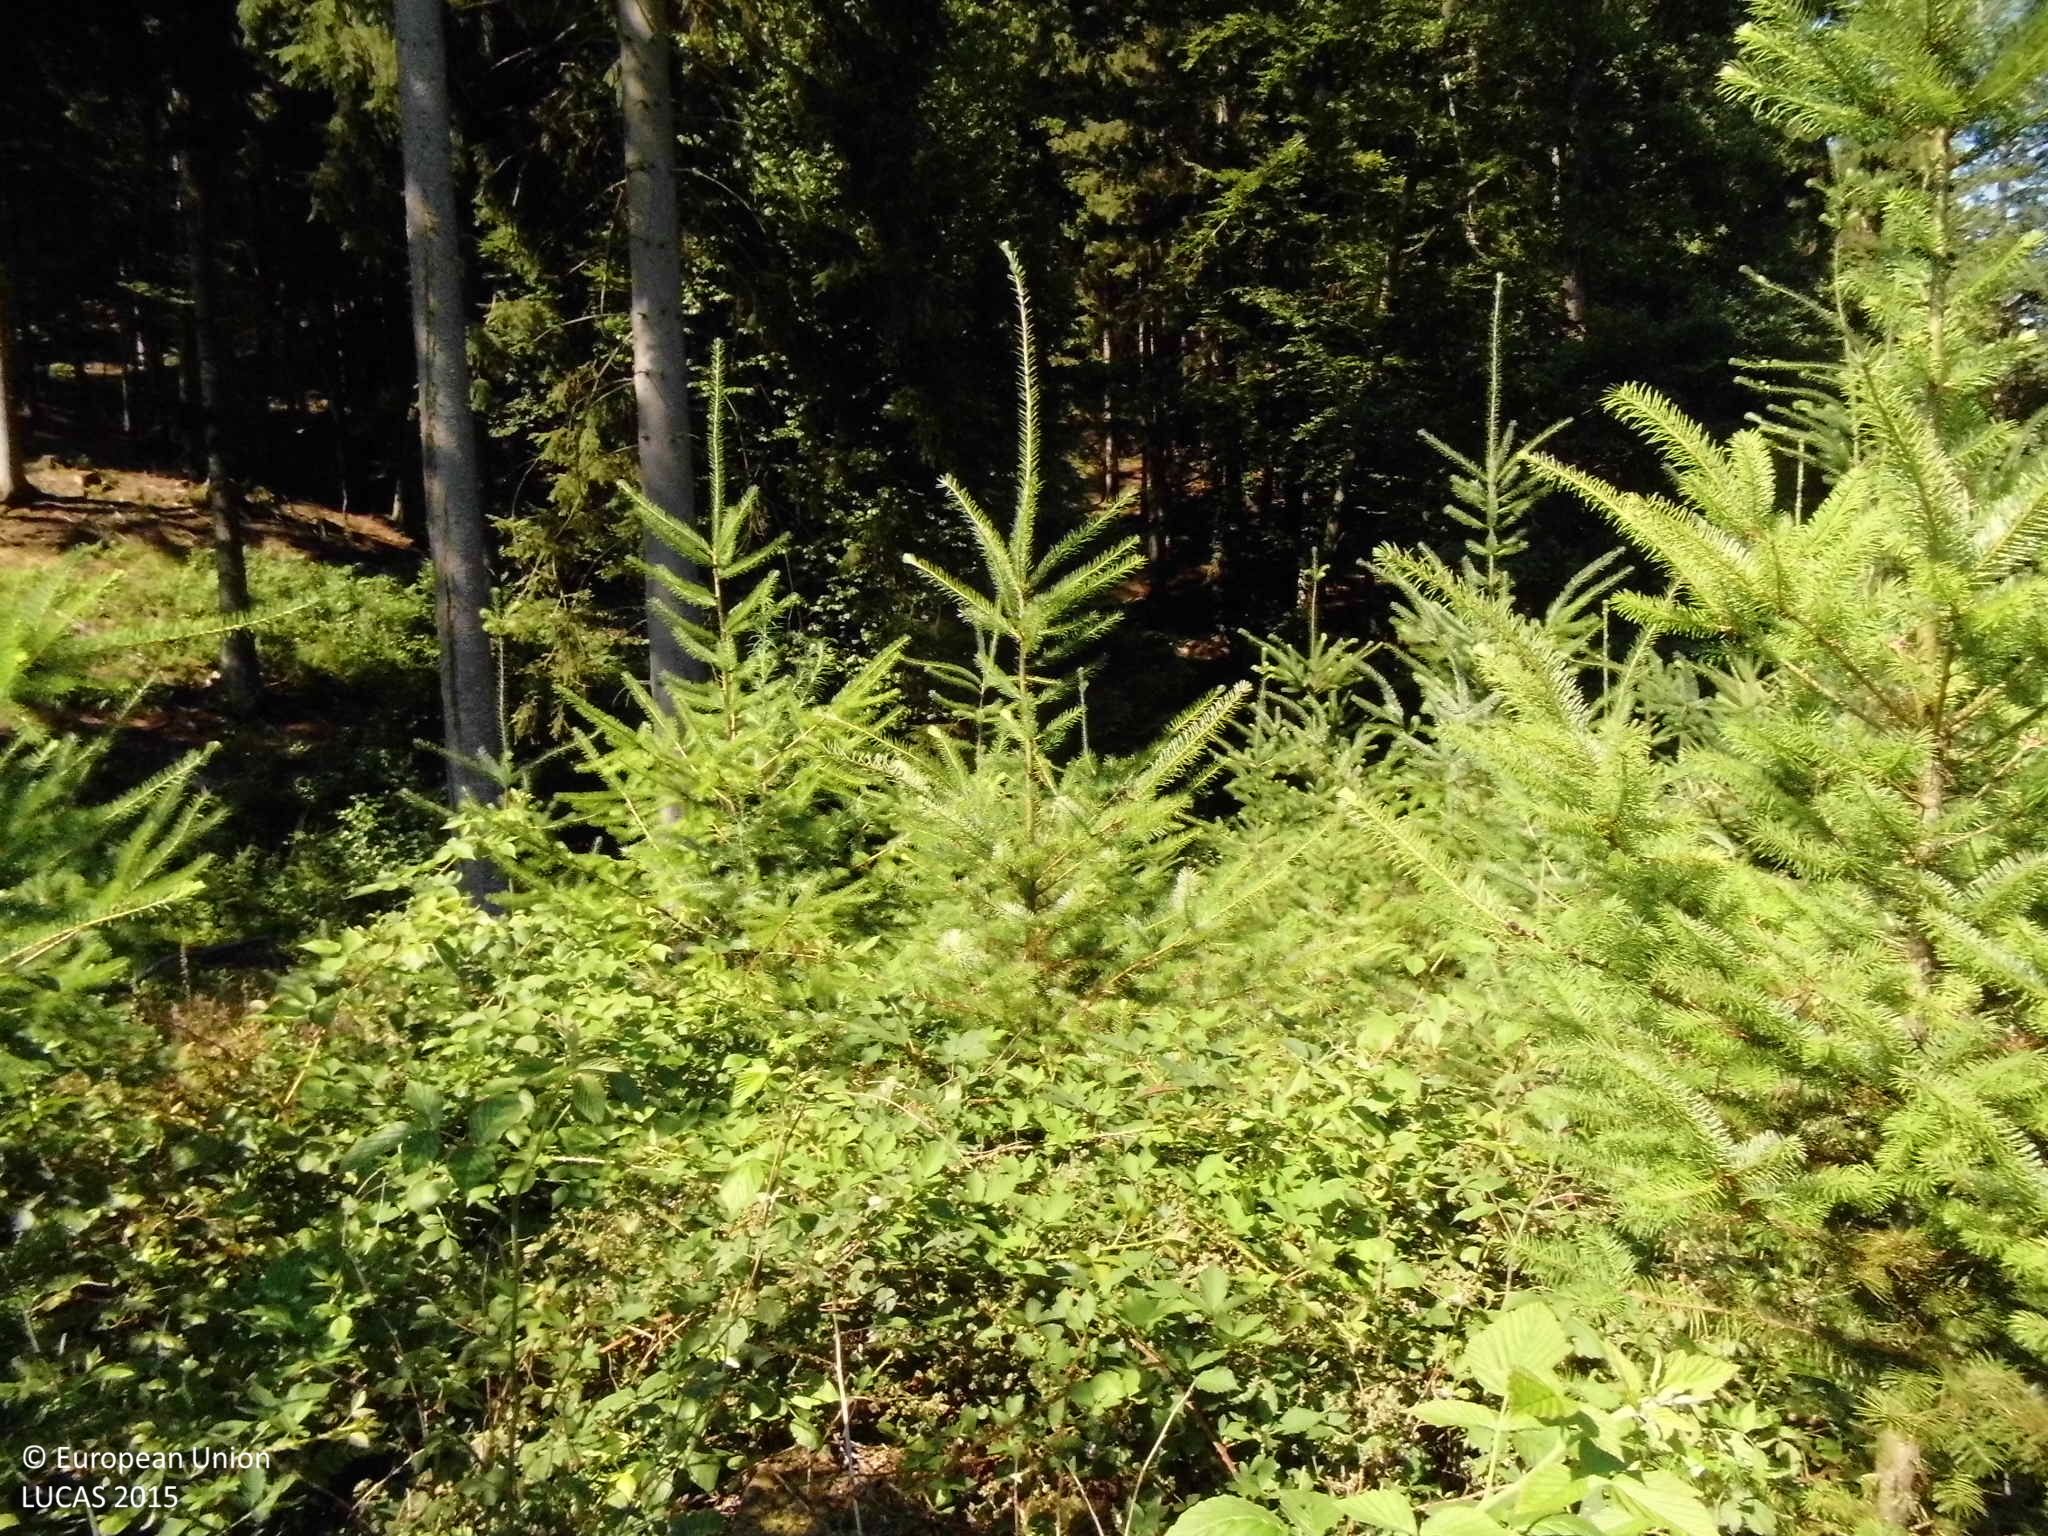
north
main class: Woodland
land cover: Other coniferous woodland
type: hemiboreal forest and nemoral coniferous forest and mixed broadleaved-coniferous forest
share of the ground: 25 - 50 %
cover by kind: coniferous forest trees 45 %, herbaceous plants 25 %, broadleaved forest trees 15 %, shrubs 15 %
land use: Forestry
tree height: < 5 m
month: August
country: DE
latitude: 51.1556
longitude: 7.9844
